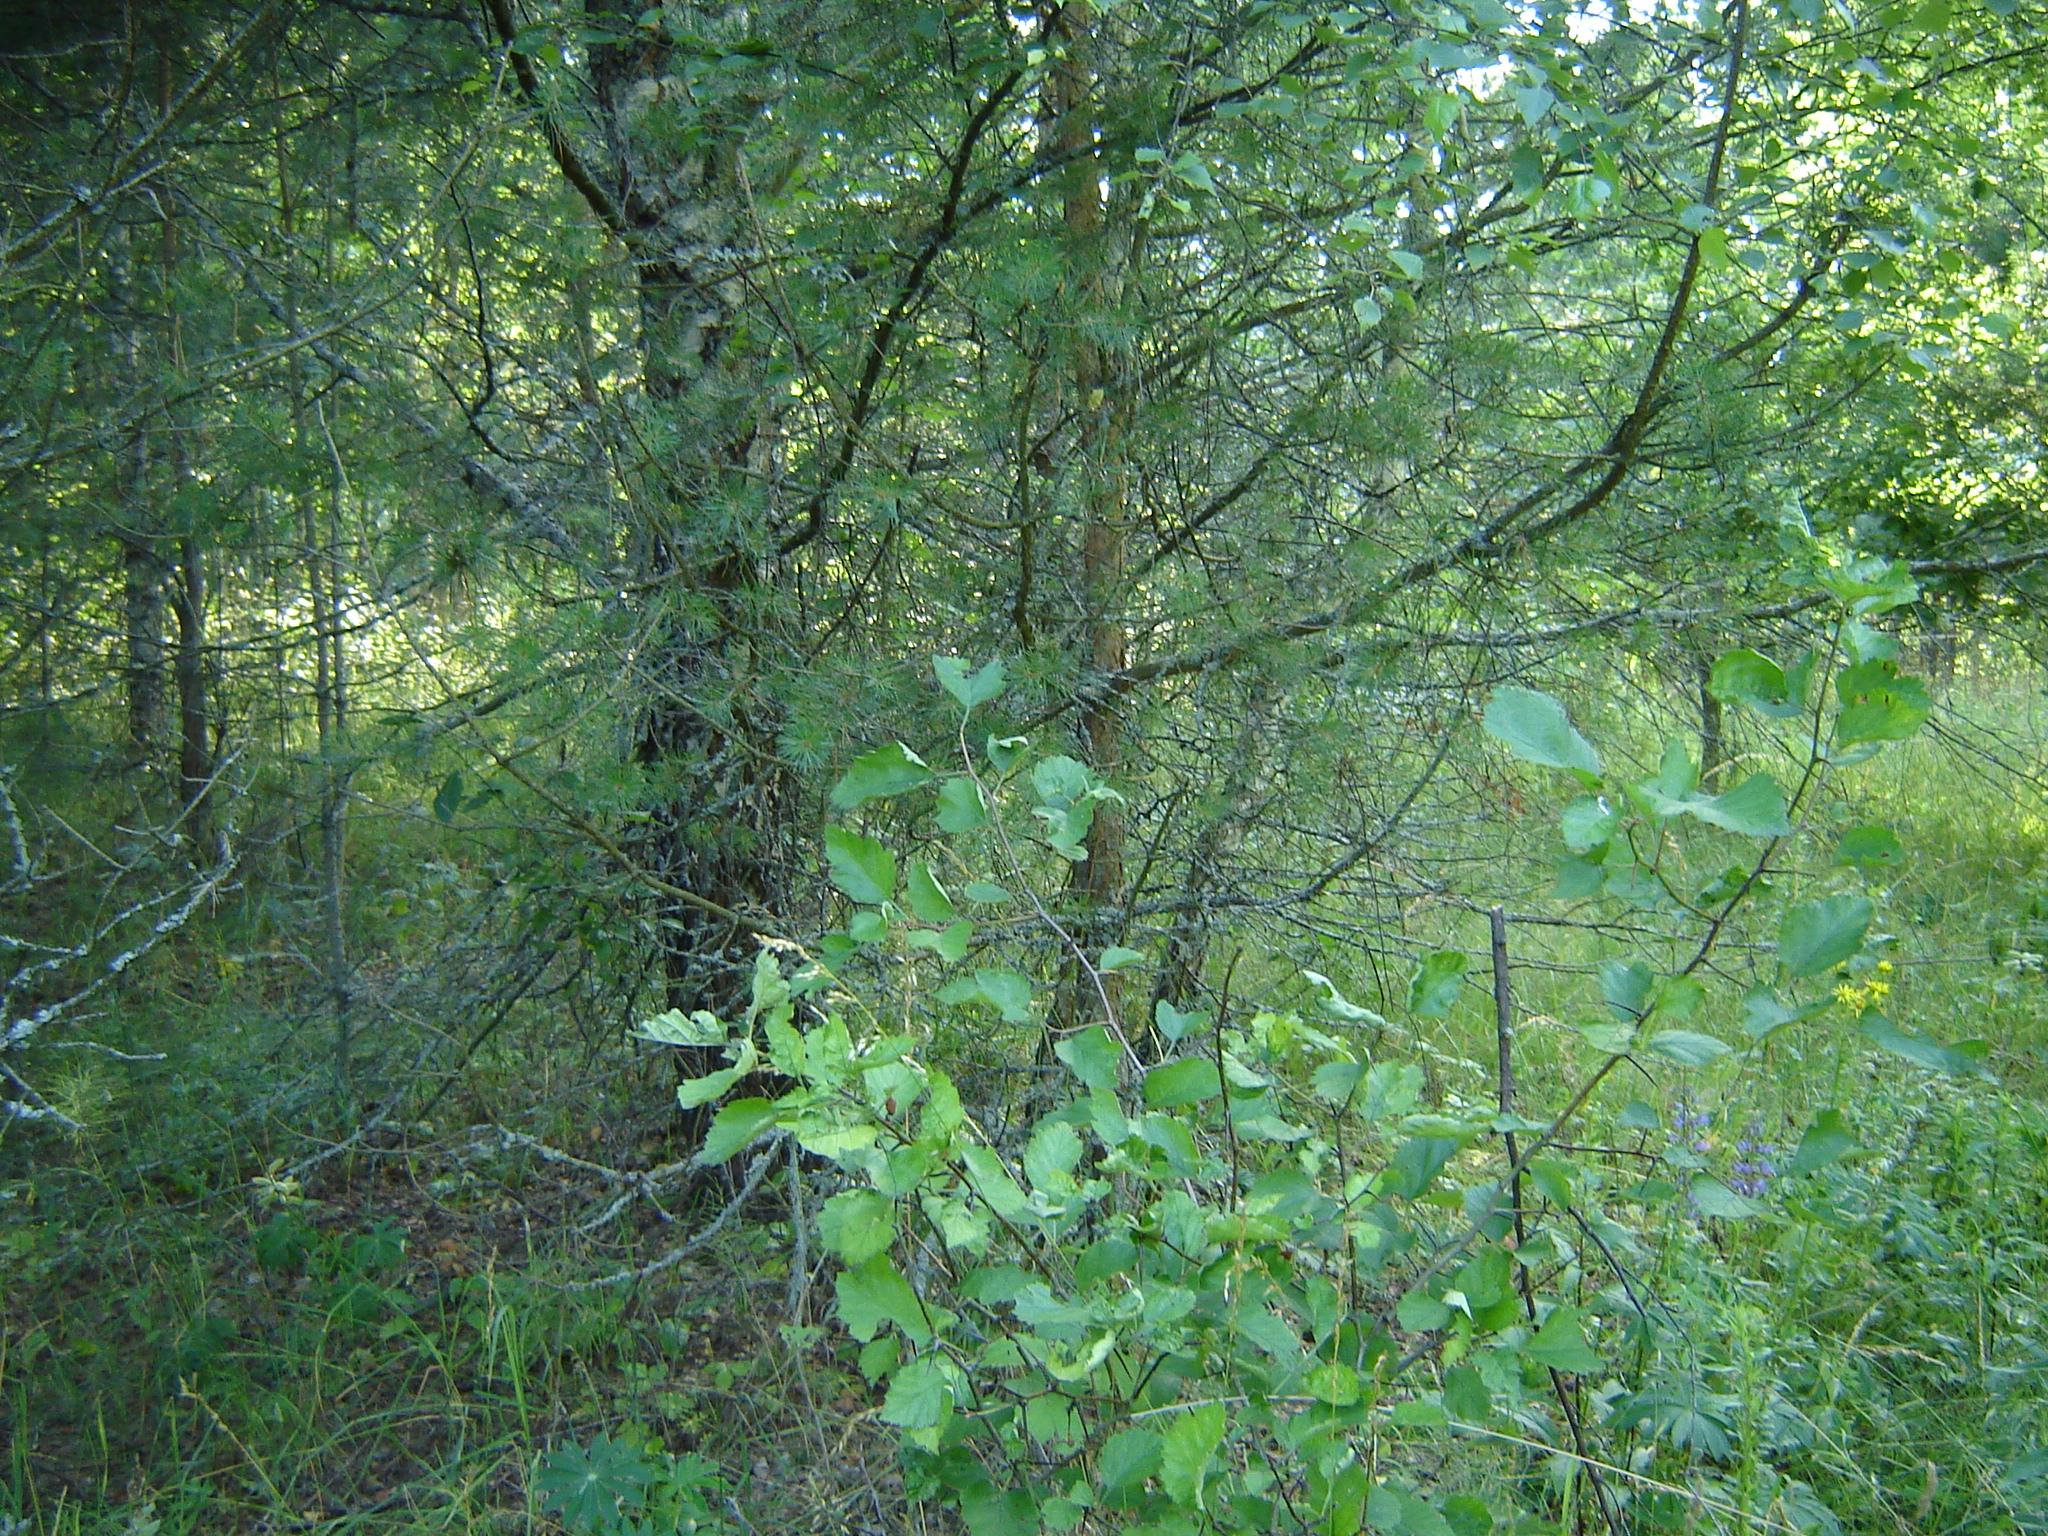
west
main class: Woodland
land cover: Pine dominated mixed woodland
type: hemiboreal forest and nemoral coniferous forest and mixed broadleaved-coniferous forest
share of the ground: > 75 %
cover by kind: coniferous forest trees 45 %, broadleaved forest trees 30 %, herbaceous plants 25 %
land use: Forestry
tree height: > 5 m
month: July
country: LT
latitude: 55.2988
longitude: 25.4489
